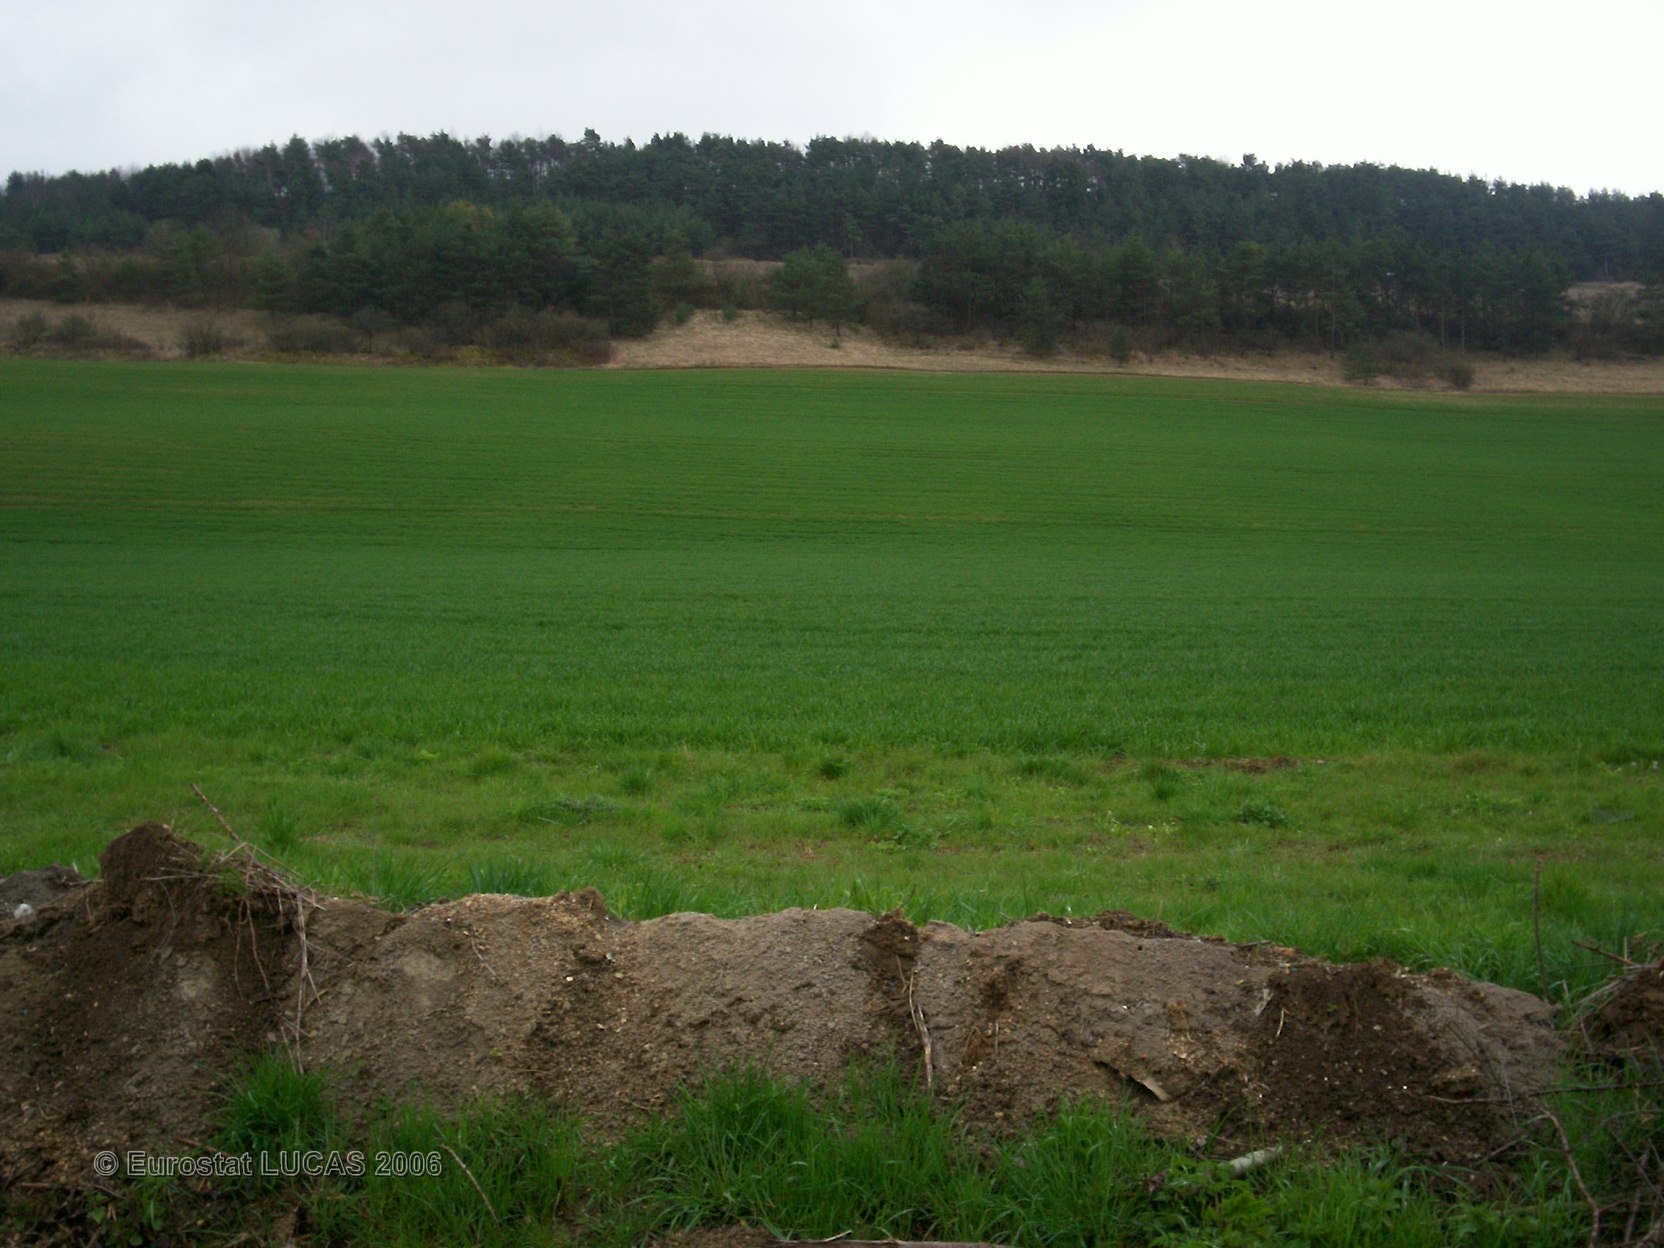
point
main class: Cropland
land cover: Common wheat
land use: Agriculture (excluding fallow land and kitchen gardens)
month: April
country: FR
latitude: 48.0853
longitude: 4.4803
